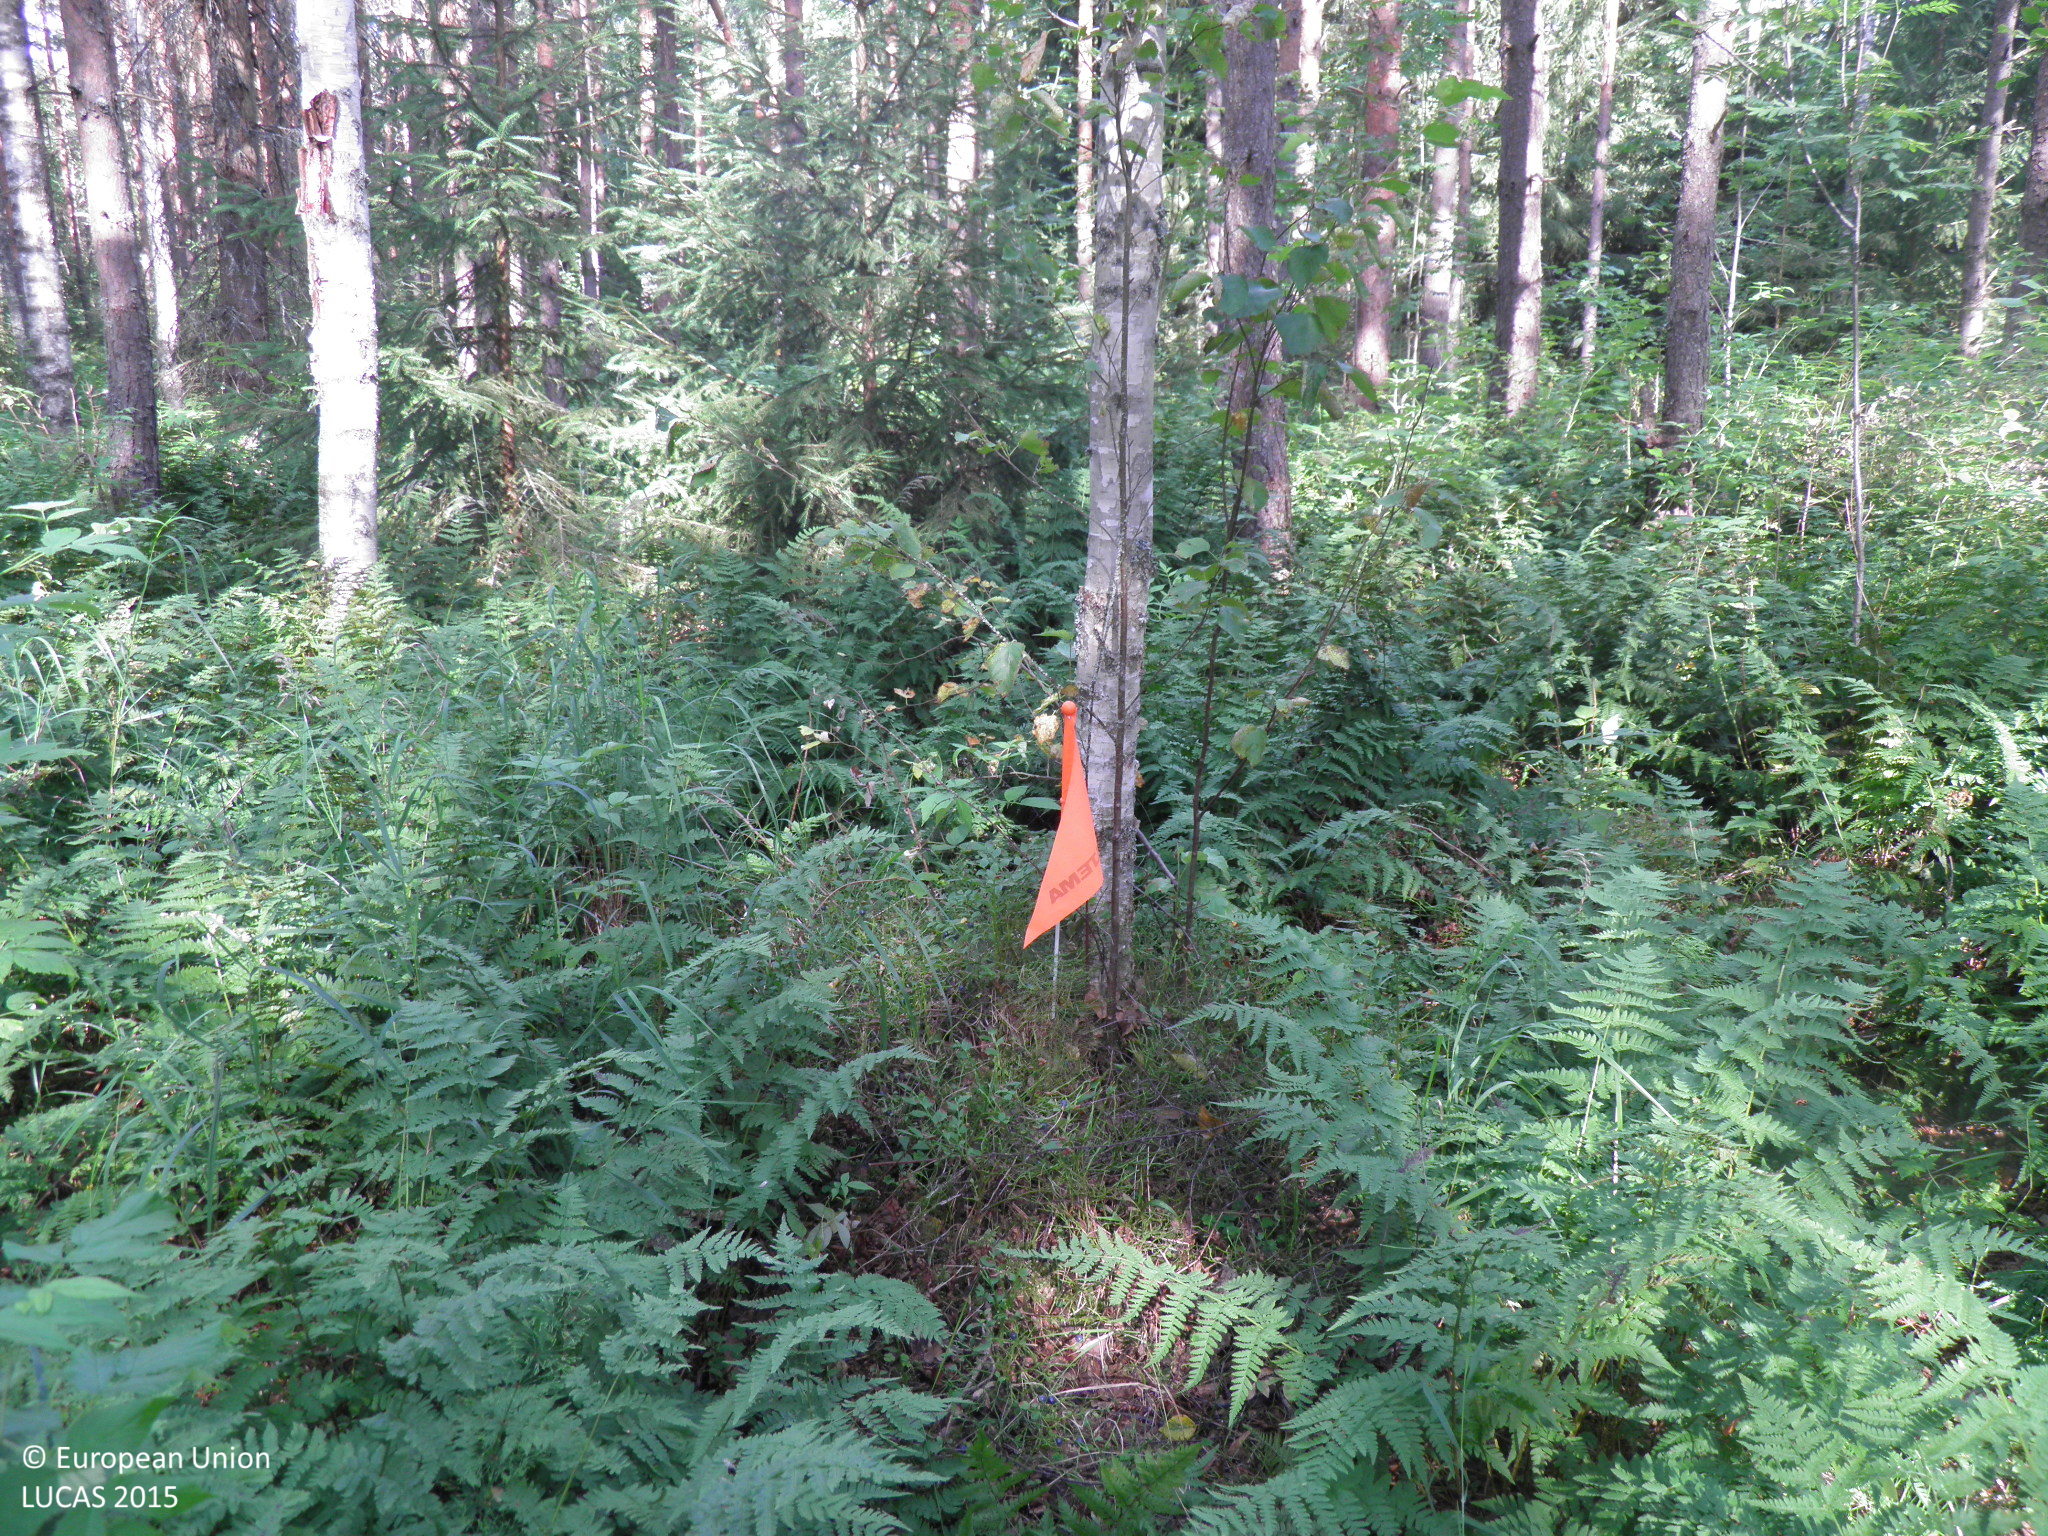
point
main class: Woodland
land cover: Pine dominated mixed woodland
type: hemiboreal forest and nemoral coniferous forest and mixed broadleaved-coniferous forest
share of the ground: > 75 %
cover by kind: broadleaved forest trees 50 %, coniferous forest trees 25 %, shrubs 25 %
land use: Forestry
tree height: > 5 m
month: August
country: FI
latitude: 61.0411
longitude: 22.5651
